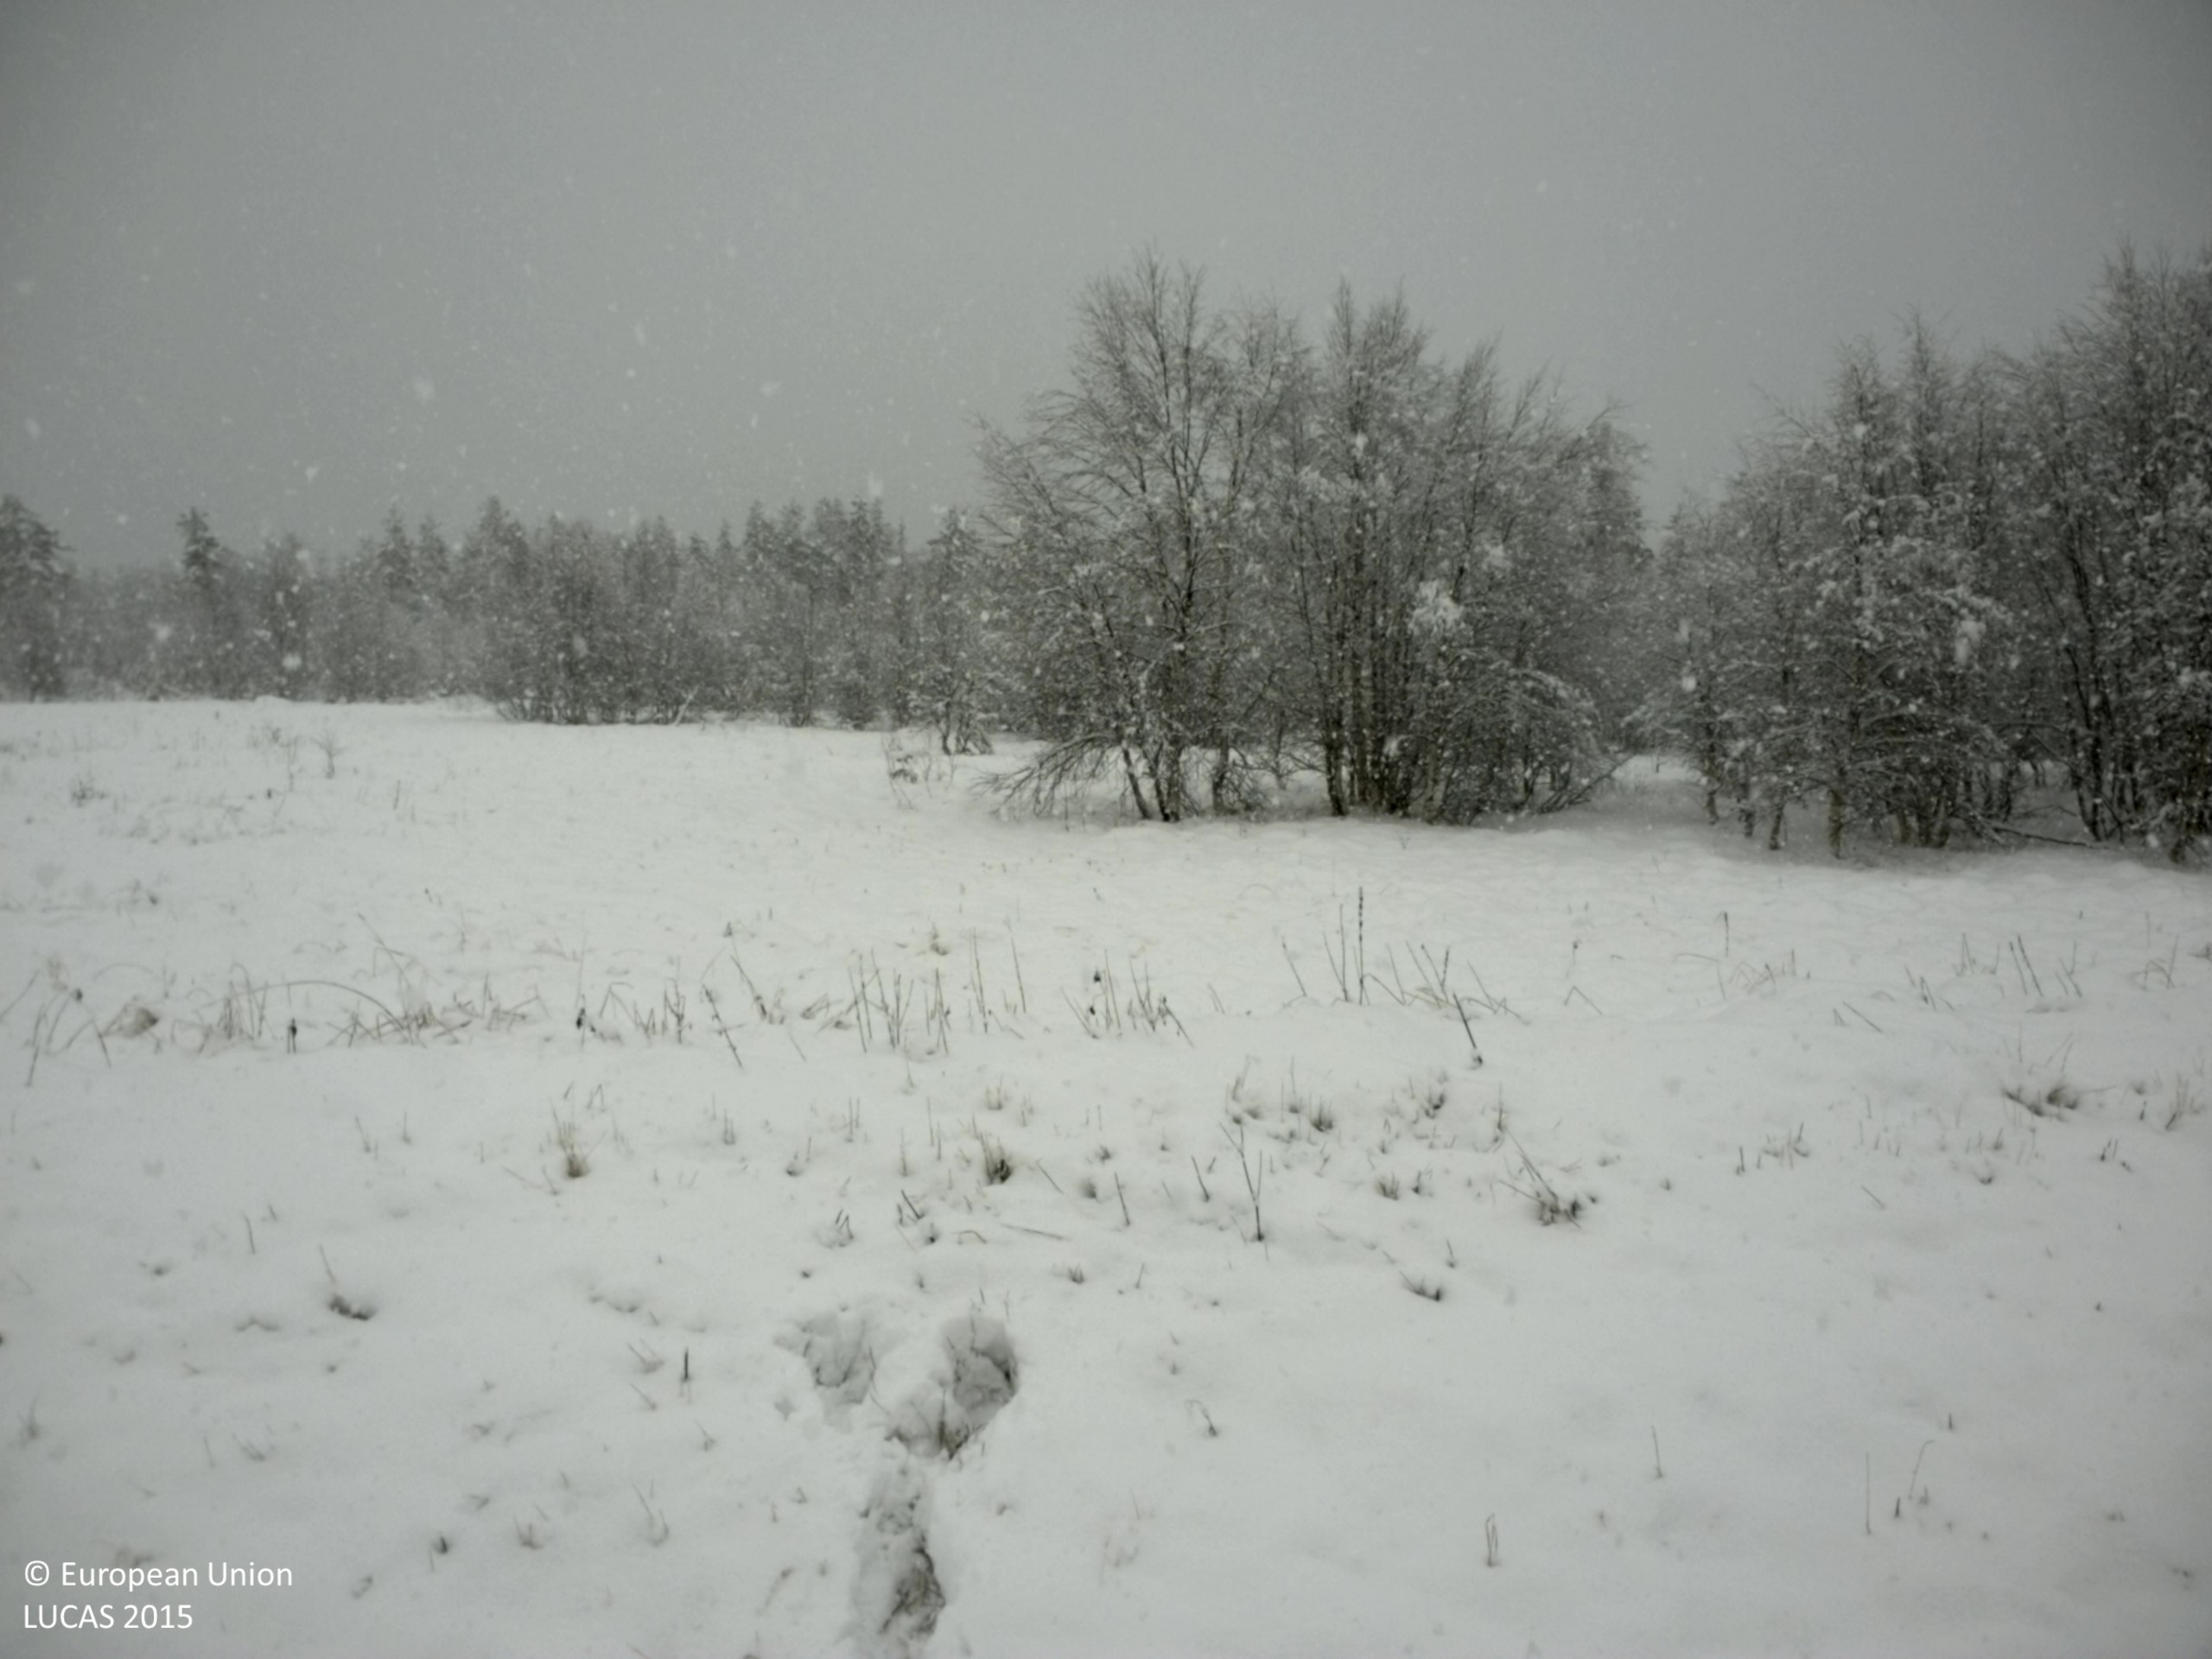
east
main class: Grassland
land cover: Grassland without tree/shrub cover
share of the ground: > 75 %
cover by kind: herbaceous plants 100 %
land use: Road transport
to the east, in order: Grassland without tree/shrub cover; Ditches and canals; Grassland without tree/shrub cover; Ditches and canals; Grassland without tree/shrub cover; Broadleaved woodland; Ditches and canals; Broadleaved woodland; Ditches and canals; Broadleaved woodland; Ditches and canals; Pine dominated mixed woodland; Ditches and canals; Pine dominated mixed woodland
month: November
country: SE
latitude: 63.7955
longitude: 15.5149
